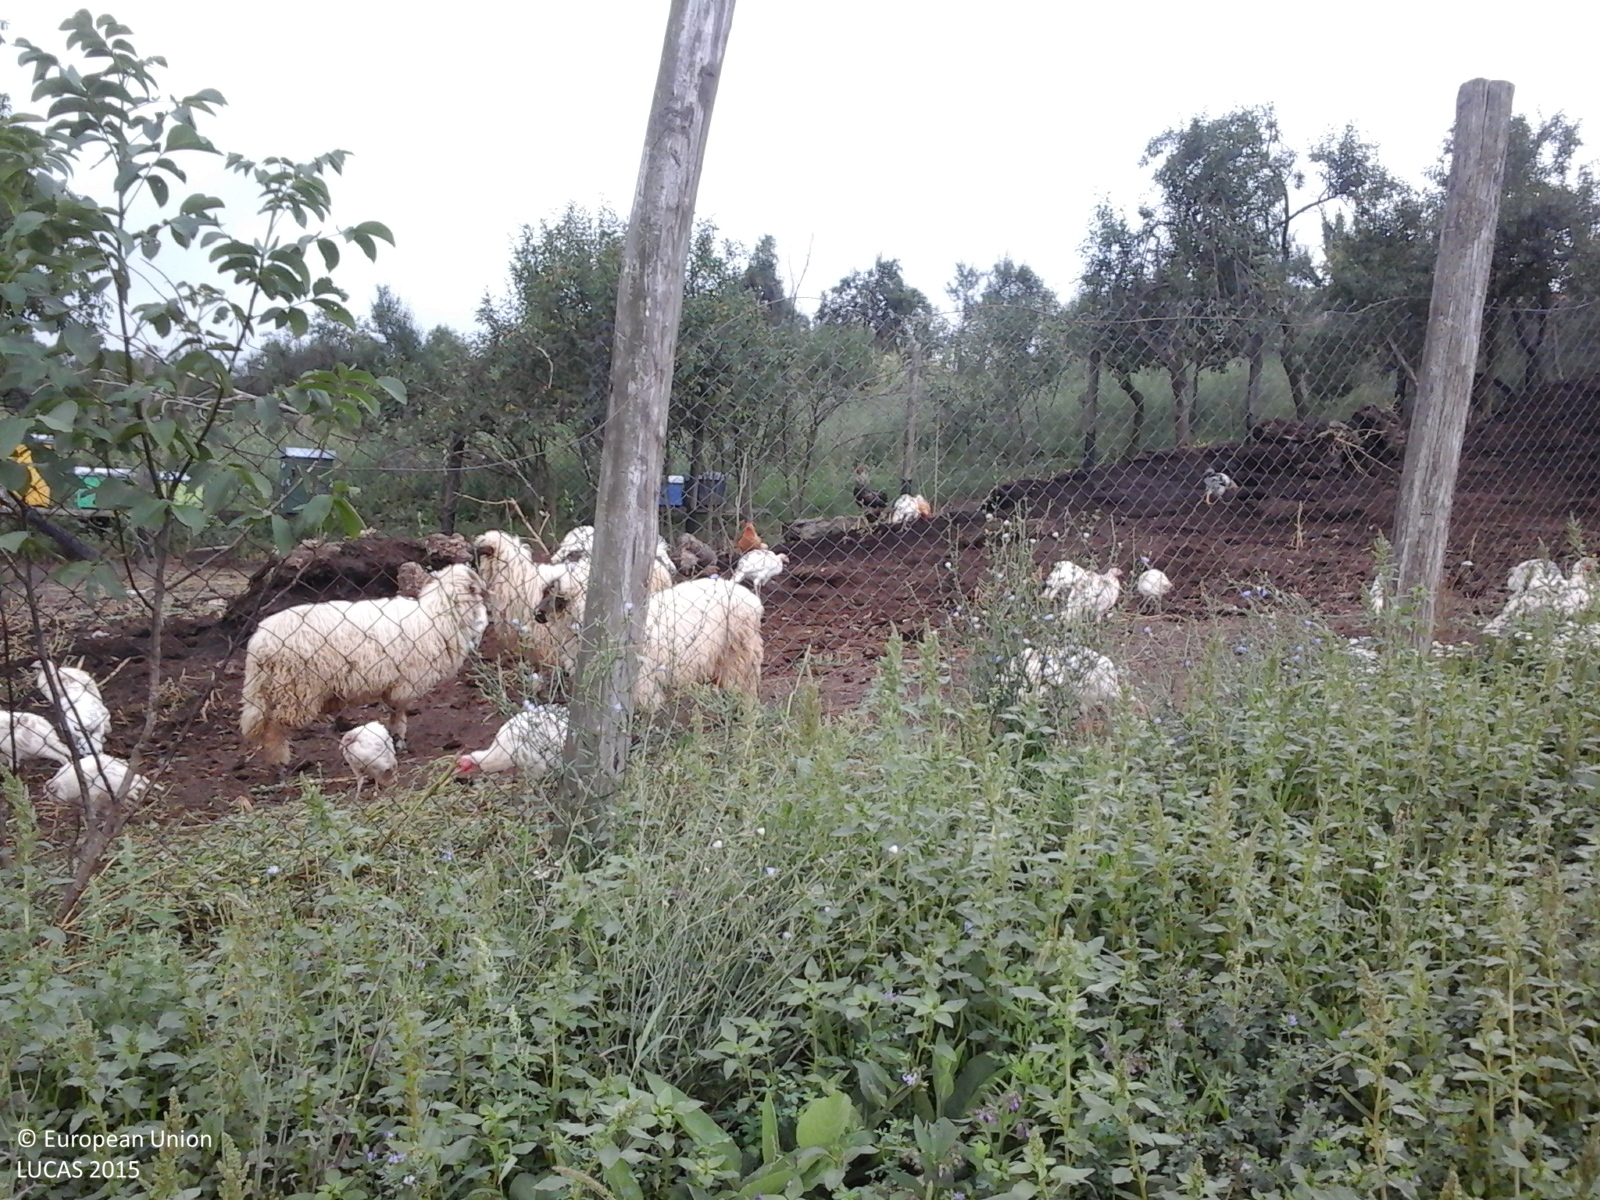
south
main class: Cropland
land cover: Lucerne
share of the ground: > 75 %
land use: Agriculture (excluding fallow land and kitchen gardens)
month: August
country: RO
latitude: 45.9672
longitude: 21.4813
